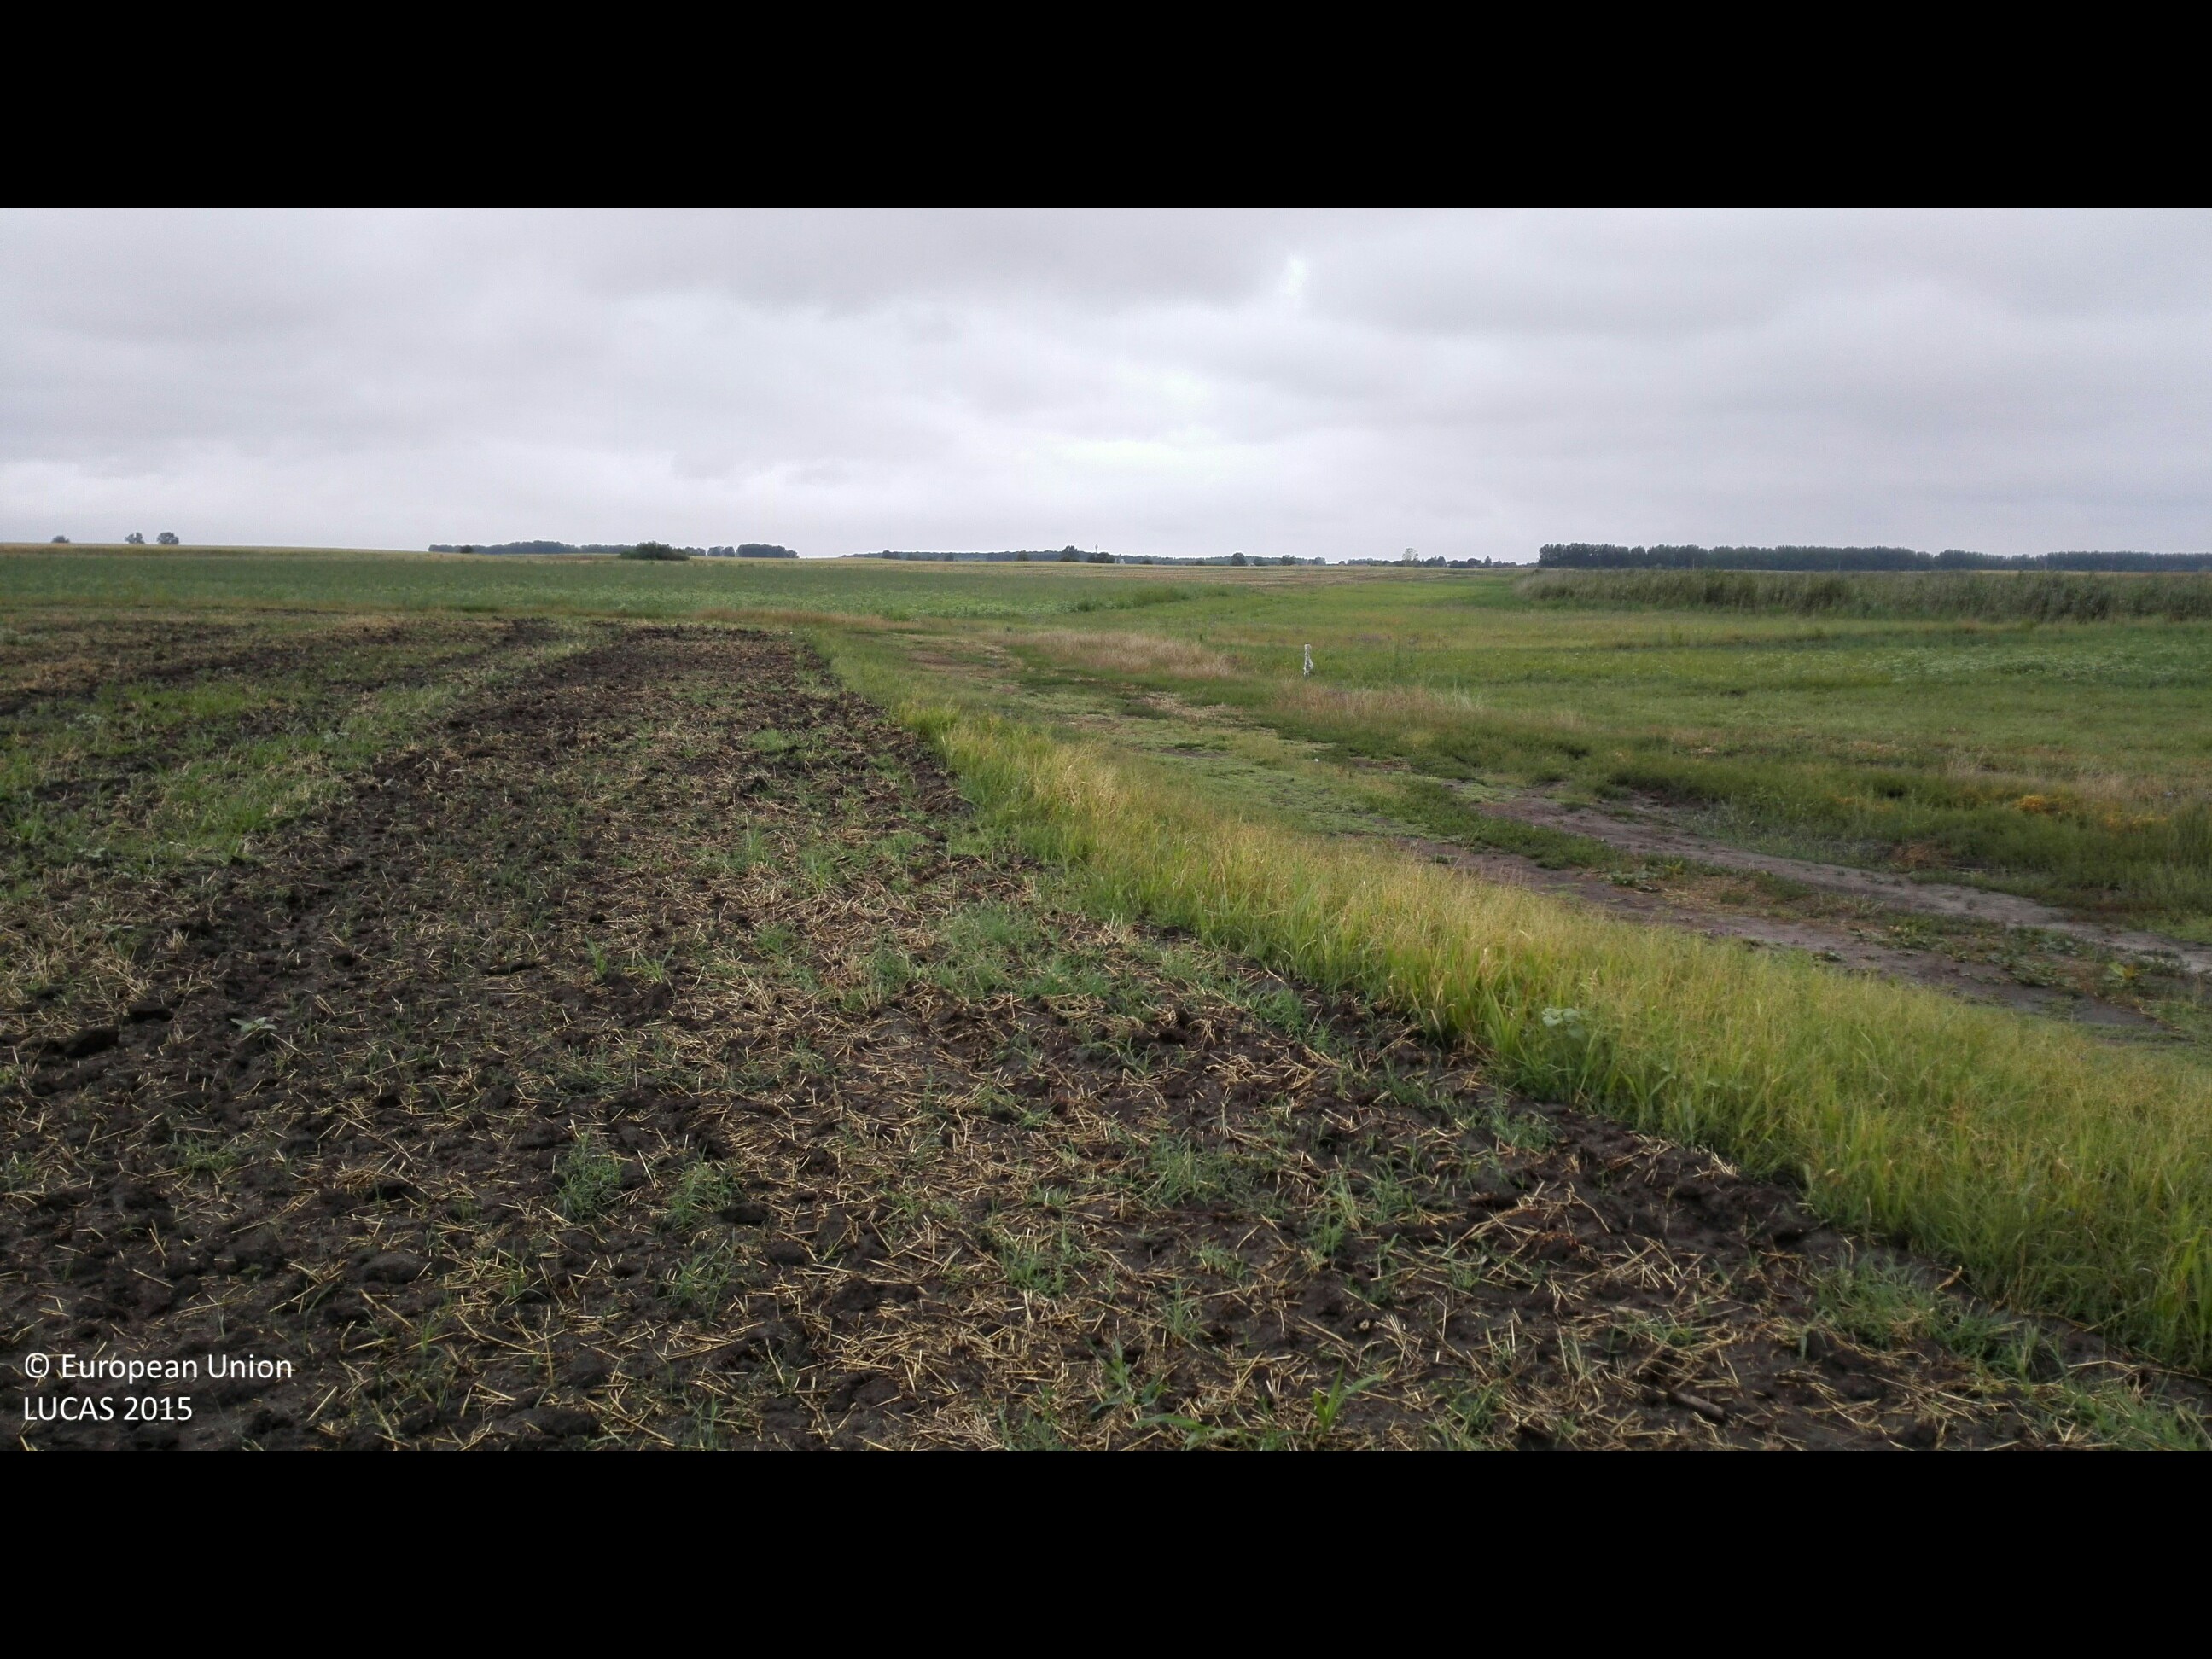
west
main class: Cropland
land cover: Common wheat
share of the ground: 10 - 25 %
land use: Agriculture (excluding fallow land and kitchen gardens)
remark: Harvested field
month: August
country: HU
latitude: 47.3075
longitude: 21.6975
